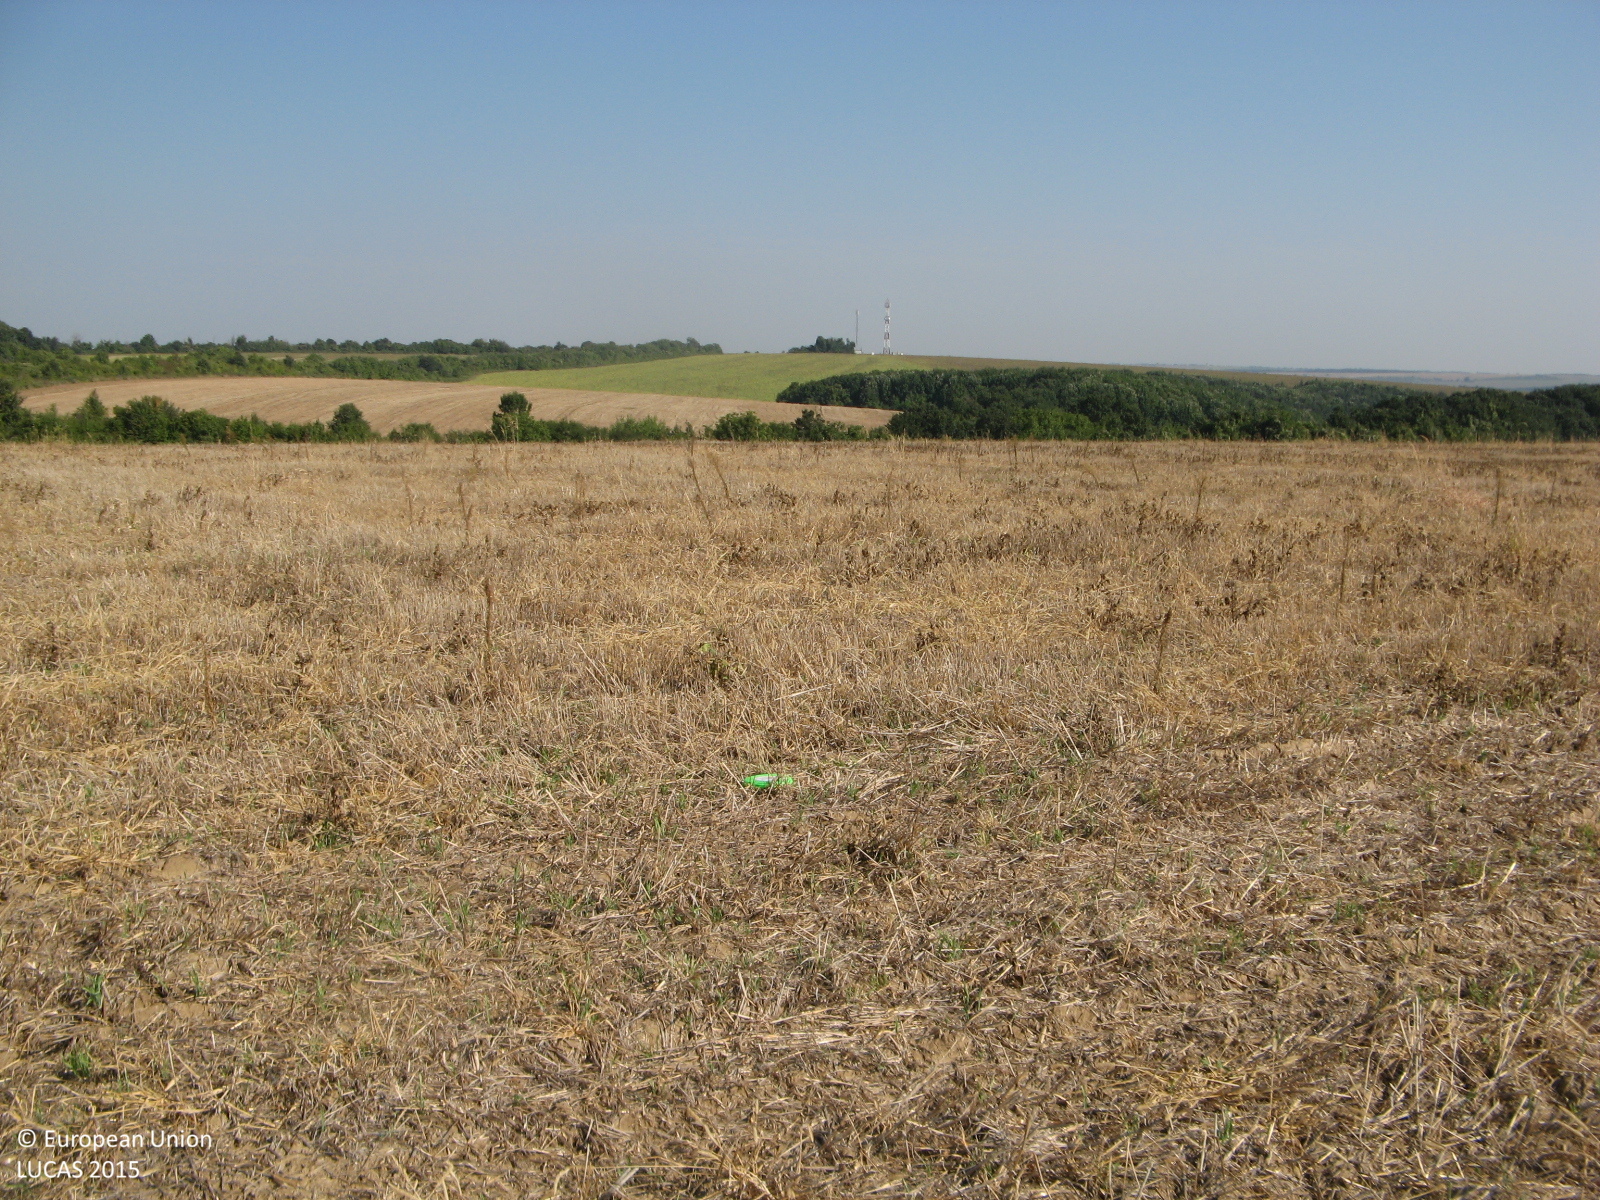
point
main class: Cropland
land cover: Barley
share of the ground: 50 - 75 %
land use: Agriculture (excluding fallow land and kitchen gardens)
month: August
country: BG
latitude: 43.5007
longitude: 25.7823
